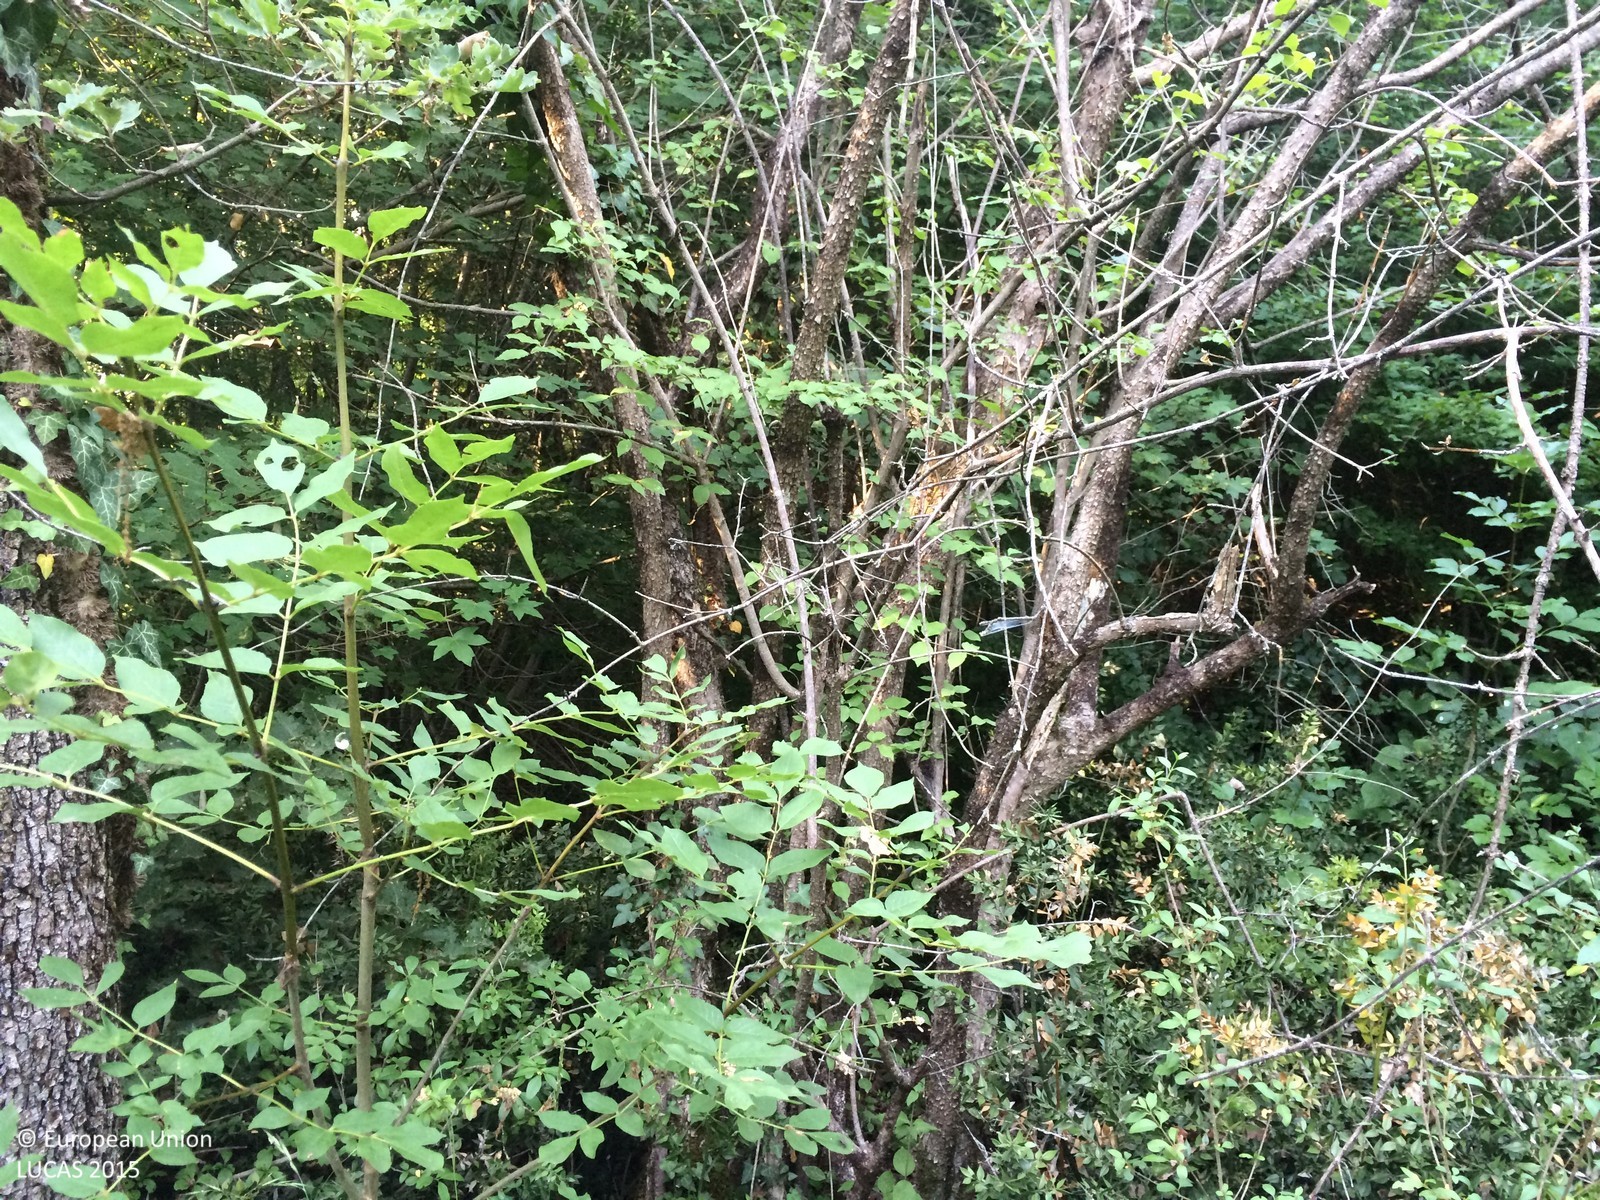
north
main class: Woodland
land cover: Broadleaved woodland
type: mesophytic deciduous forest
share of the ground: > 75 %
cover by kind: broadleaved forest trees 90 %, shrubs 10 %
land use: Semi-natural and natural areas not in use
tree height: > 5 m
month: June
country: HR
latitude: 45.0196
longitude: 13.8395
